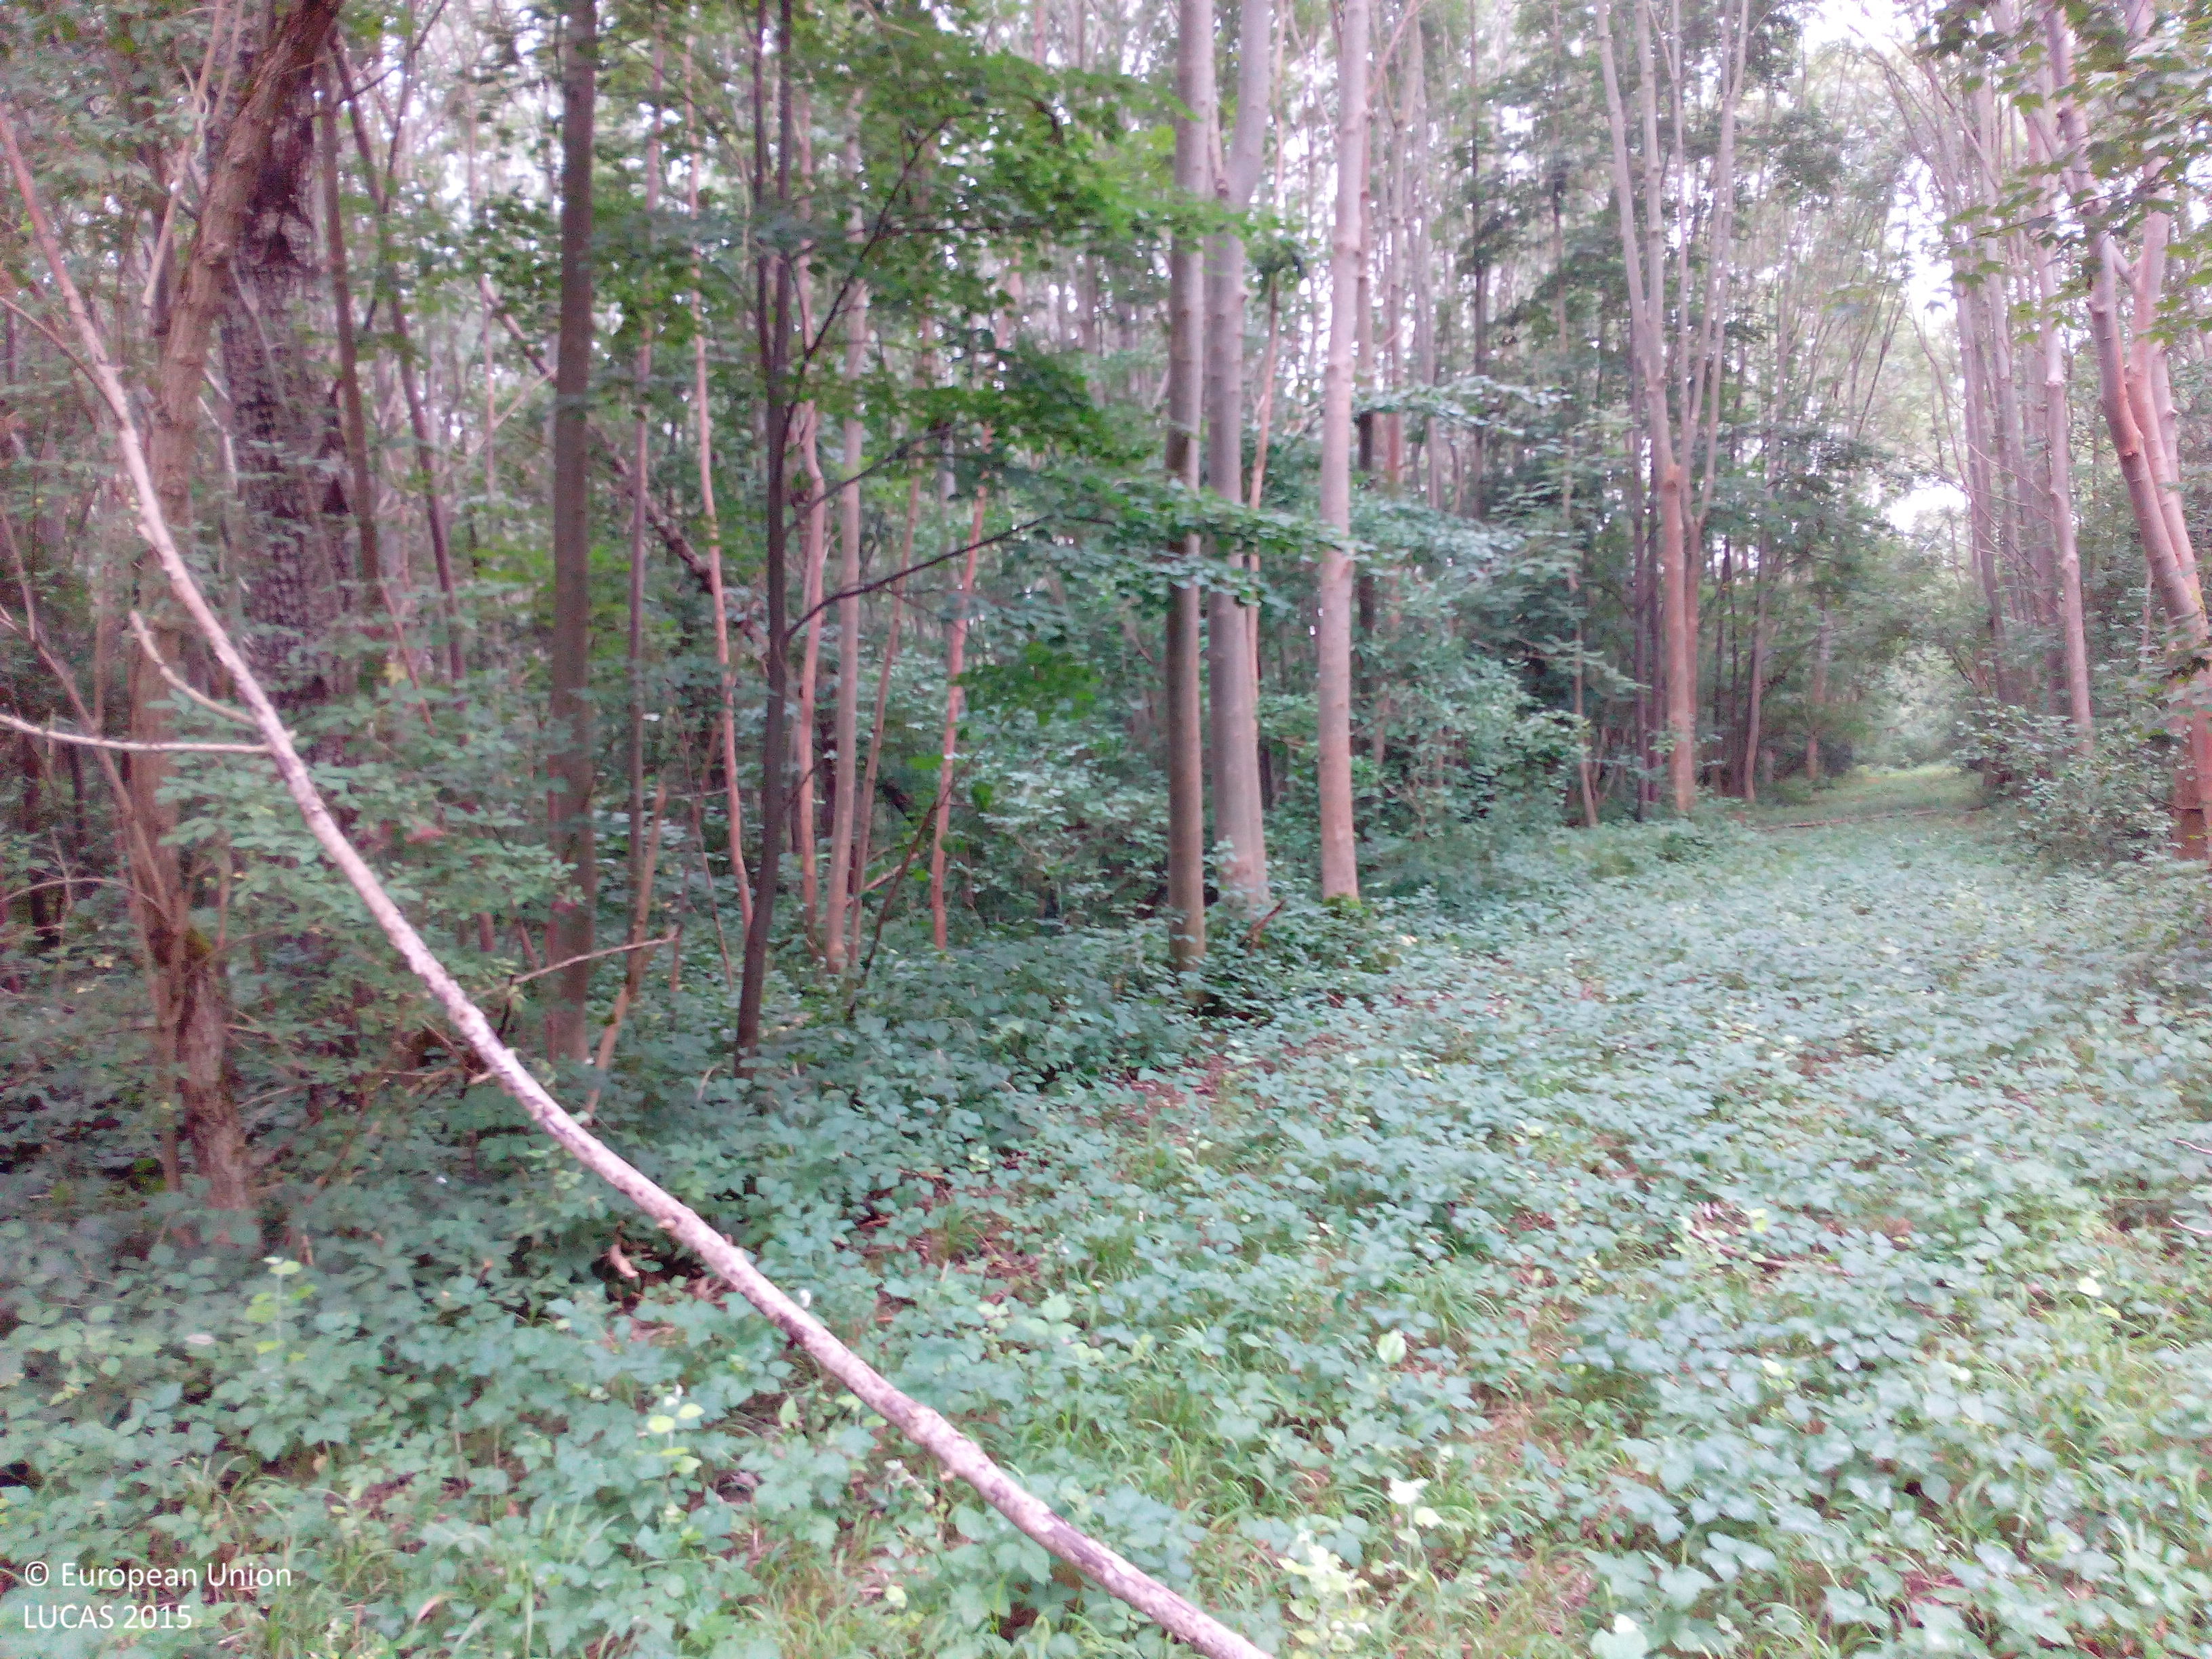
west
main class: Woodland
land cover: Broadleaved woodland
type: mesophytic deciduous forest
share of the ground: > 75 %
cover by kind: broadleaved forest trees 90 %, shrubs 5 %, herbaceous plants 5 %
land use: Forestry
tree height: > 5 m
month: August
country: DE
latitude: 51.0780
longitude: 11.0988
